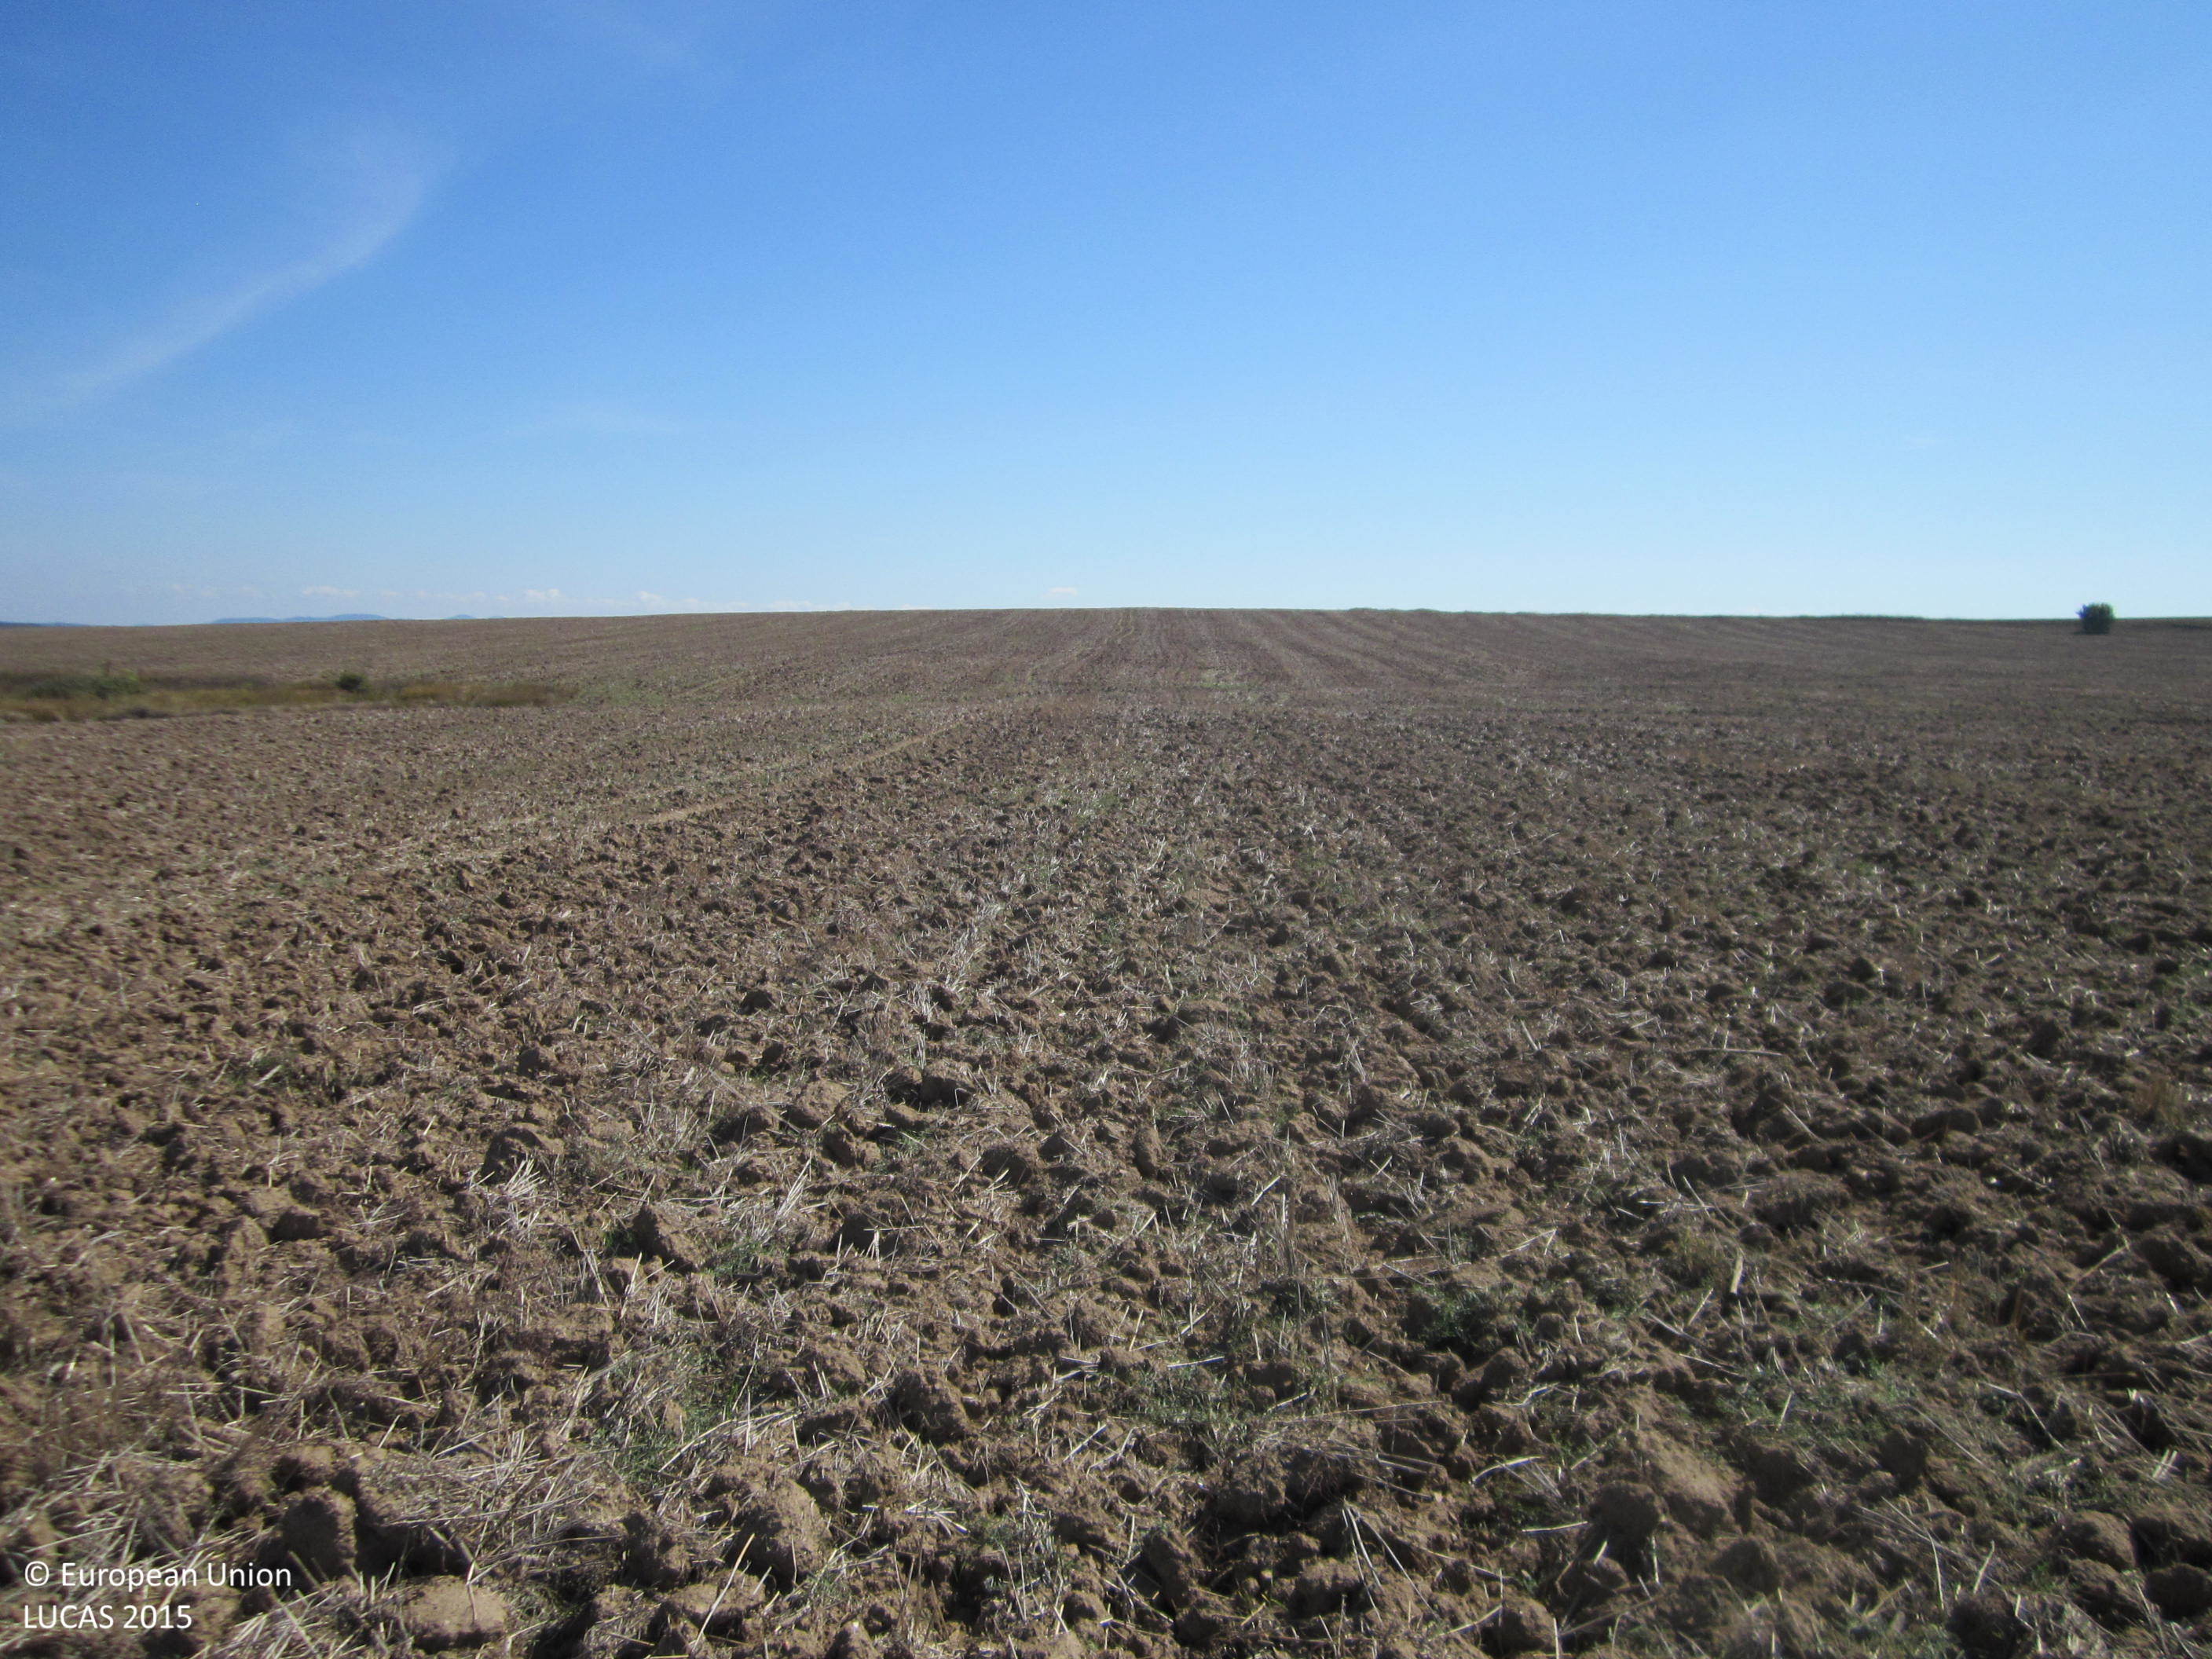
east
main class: Cropland
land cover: Common wheat
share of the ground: < 10 %
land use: Agriculture (excluding fallow land and kitchen gardens)
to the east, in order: Common wheat
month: September
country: BG
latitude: 42.1471
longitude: 26.9798
